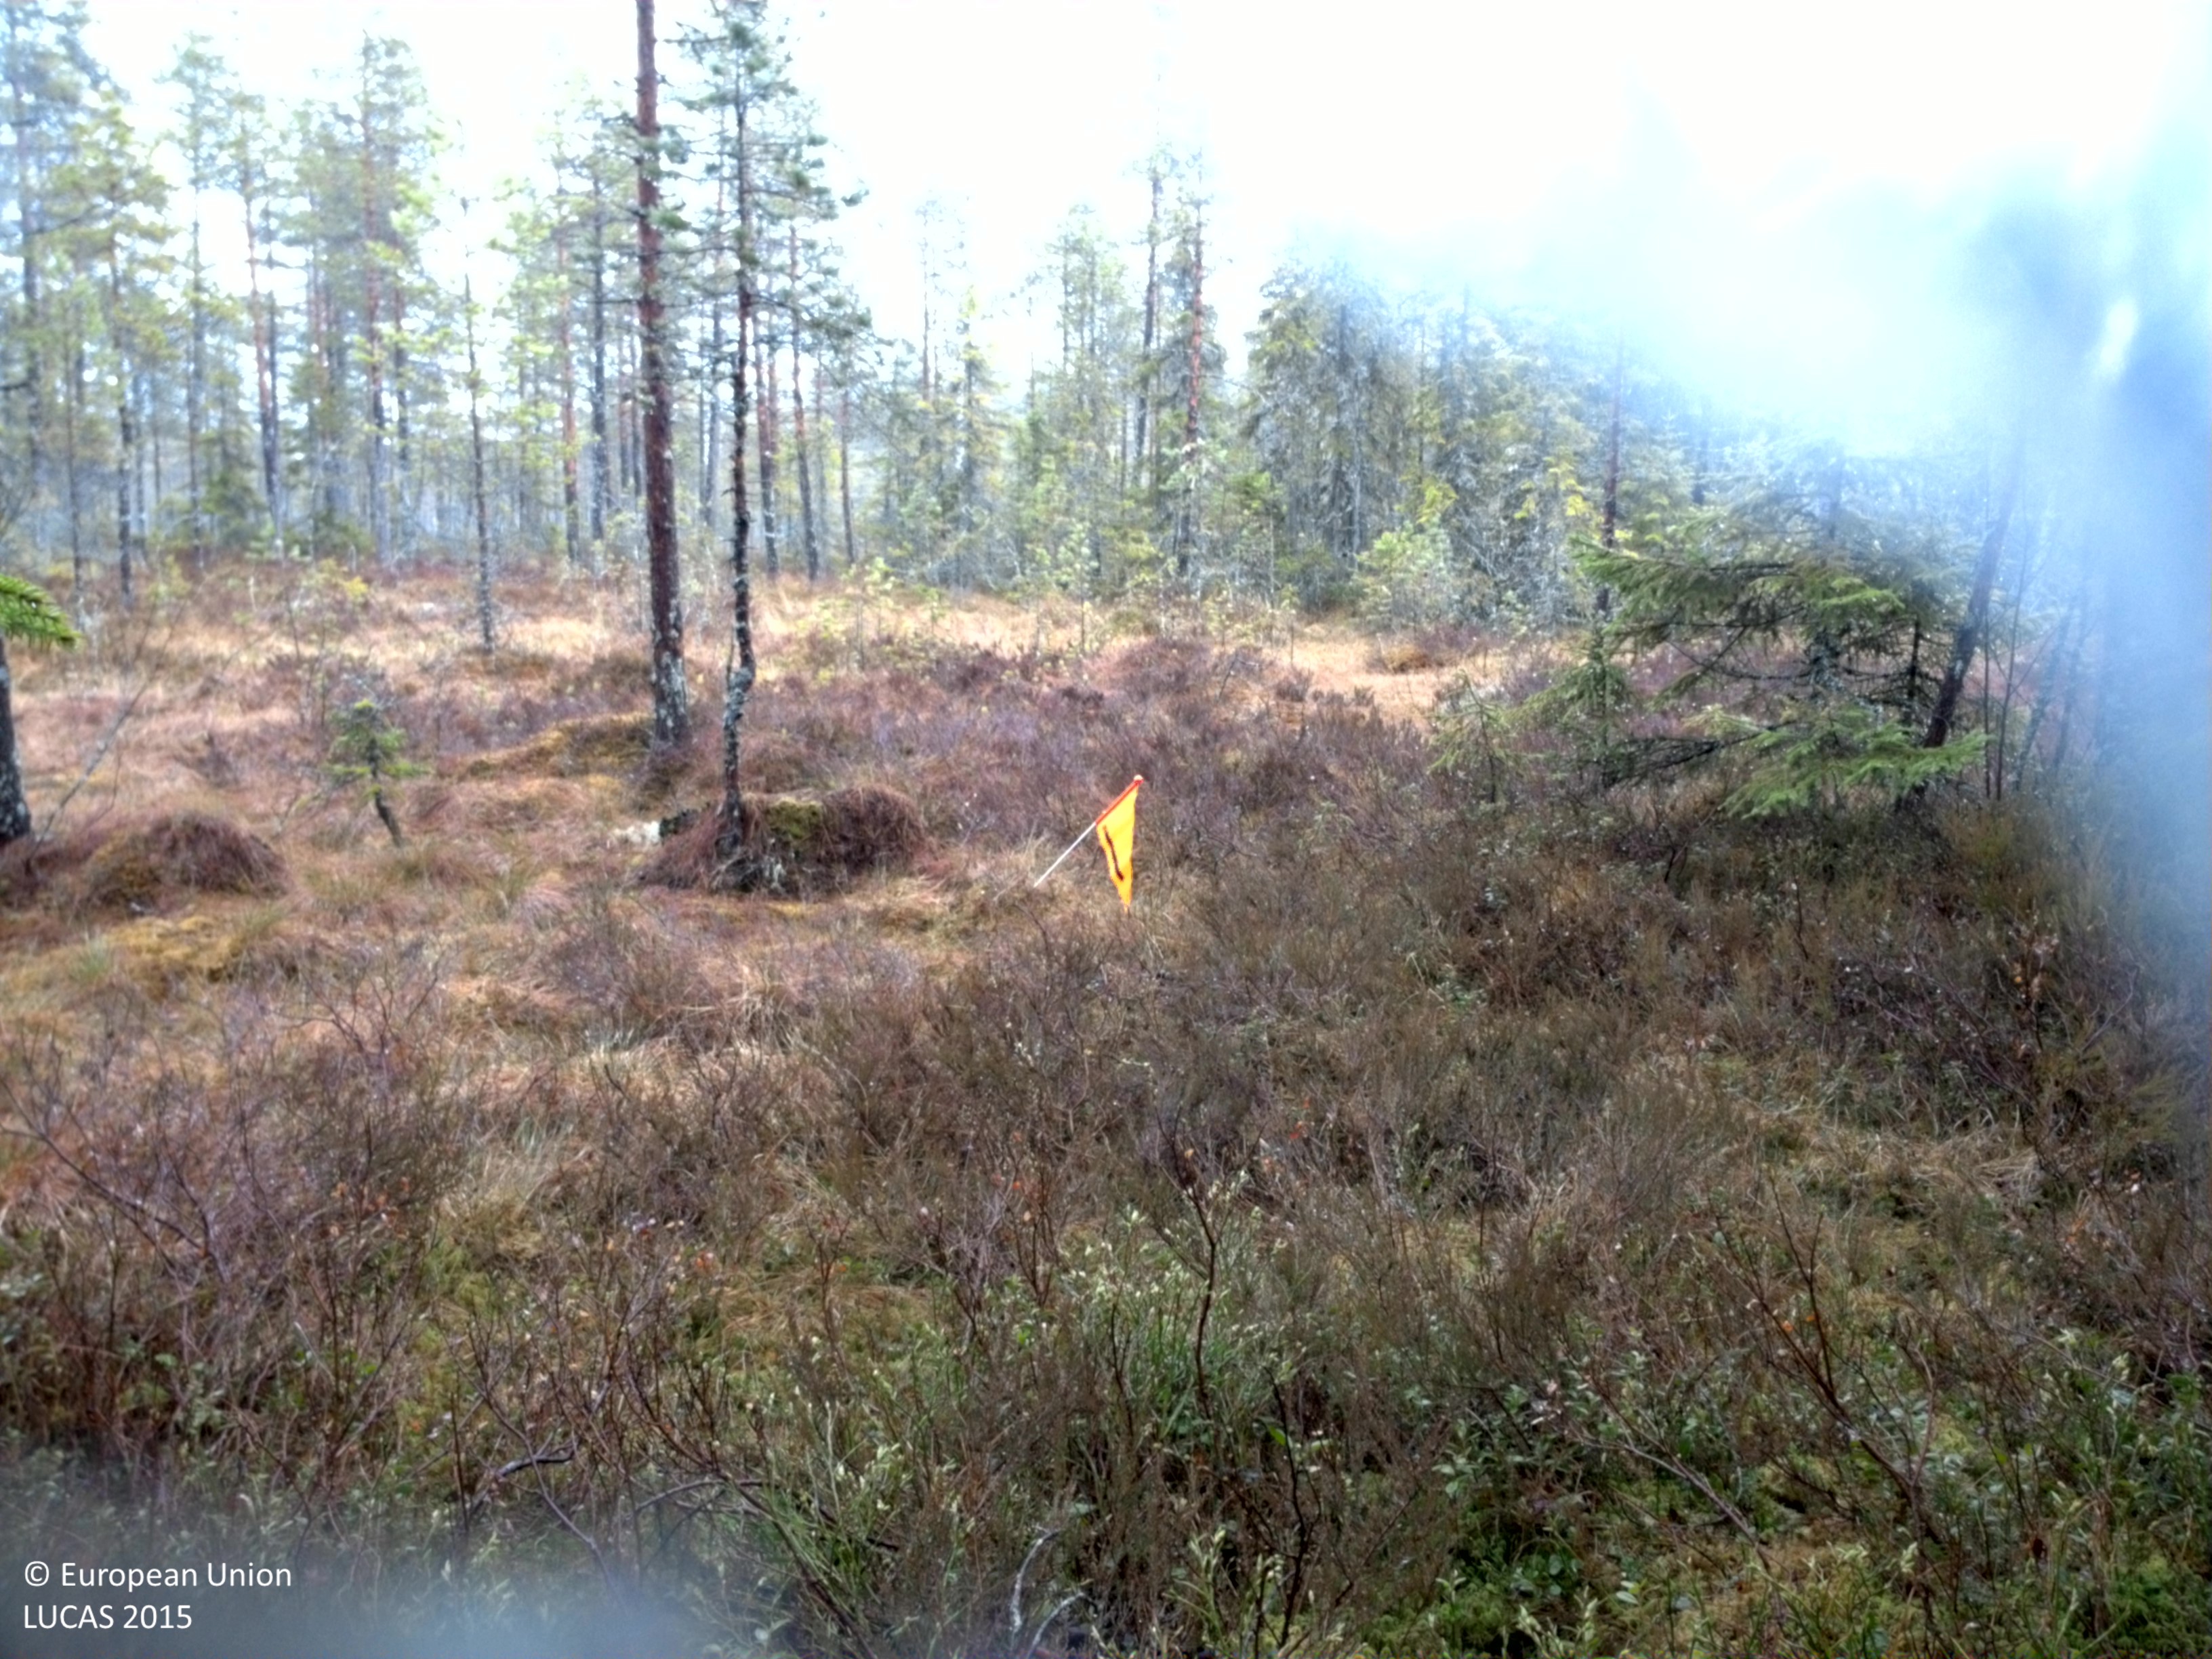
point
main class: Woodland
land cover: Pine dominated coniferous woodland
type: boreal forest
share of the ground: > 75 %
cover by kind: coniferous forest trees 80 %, herbaceous plants 20 %
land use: Forestry
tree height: > 5 m
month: May
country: SE
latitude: 61.0842
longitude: 15.0101
